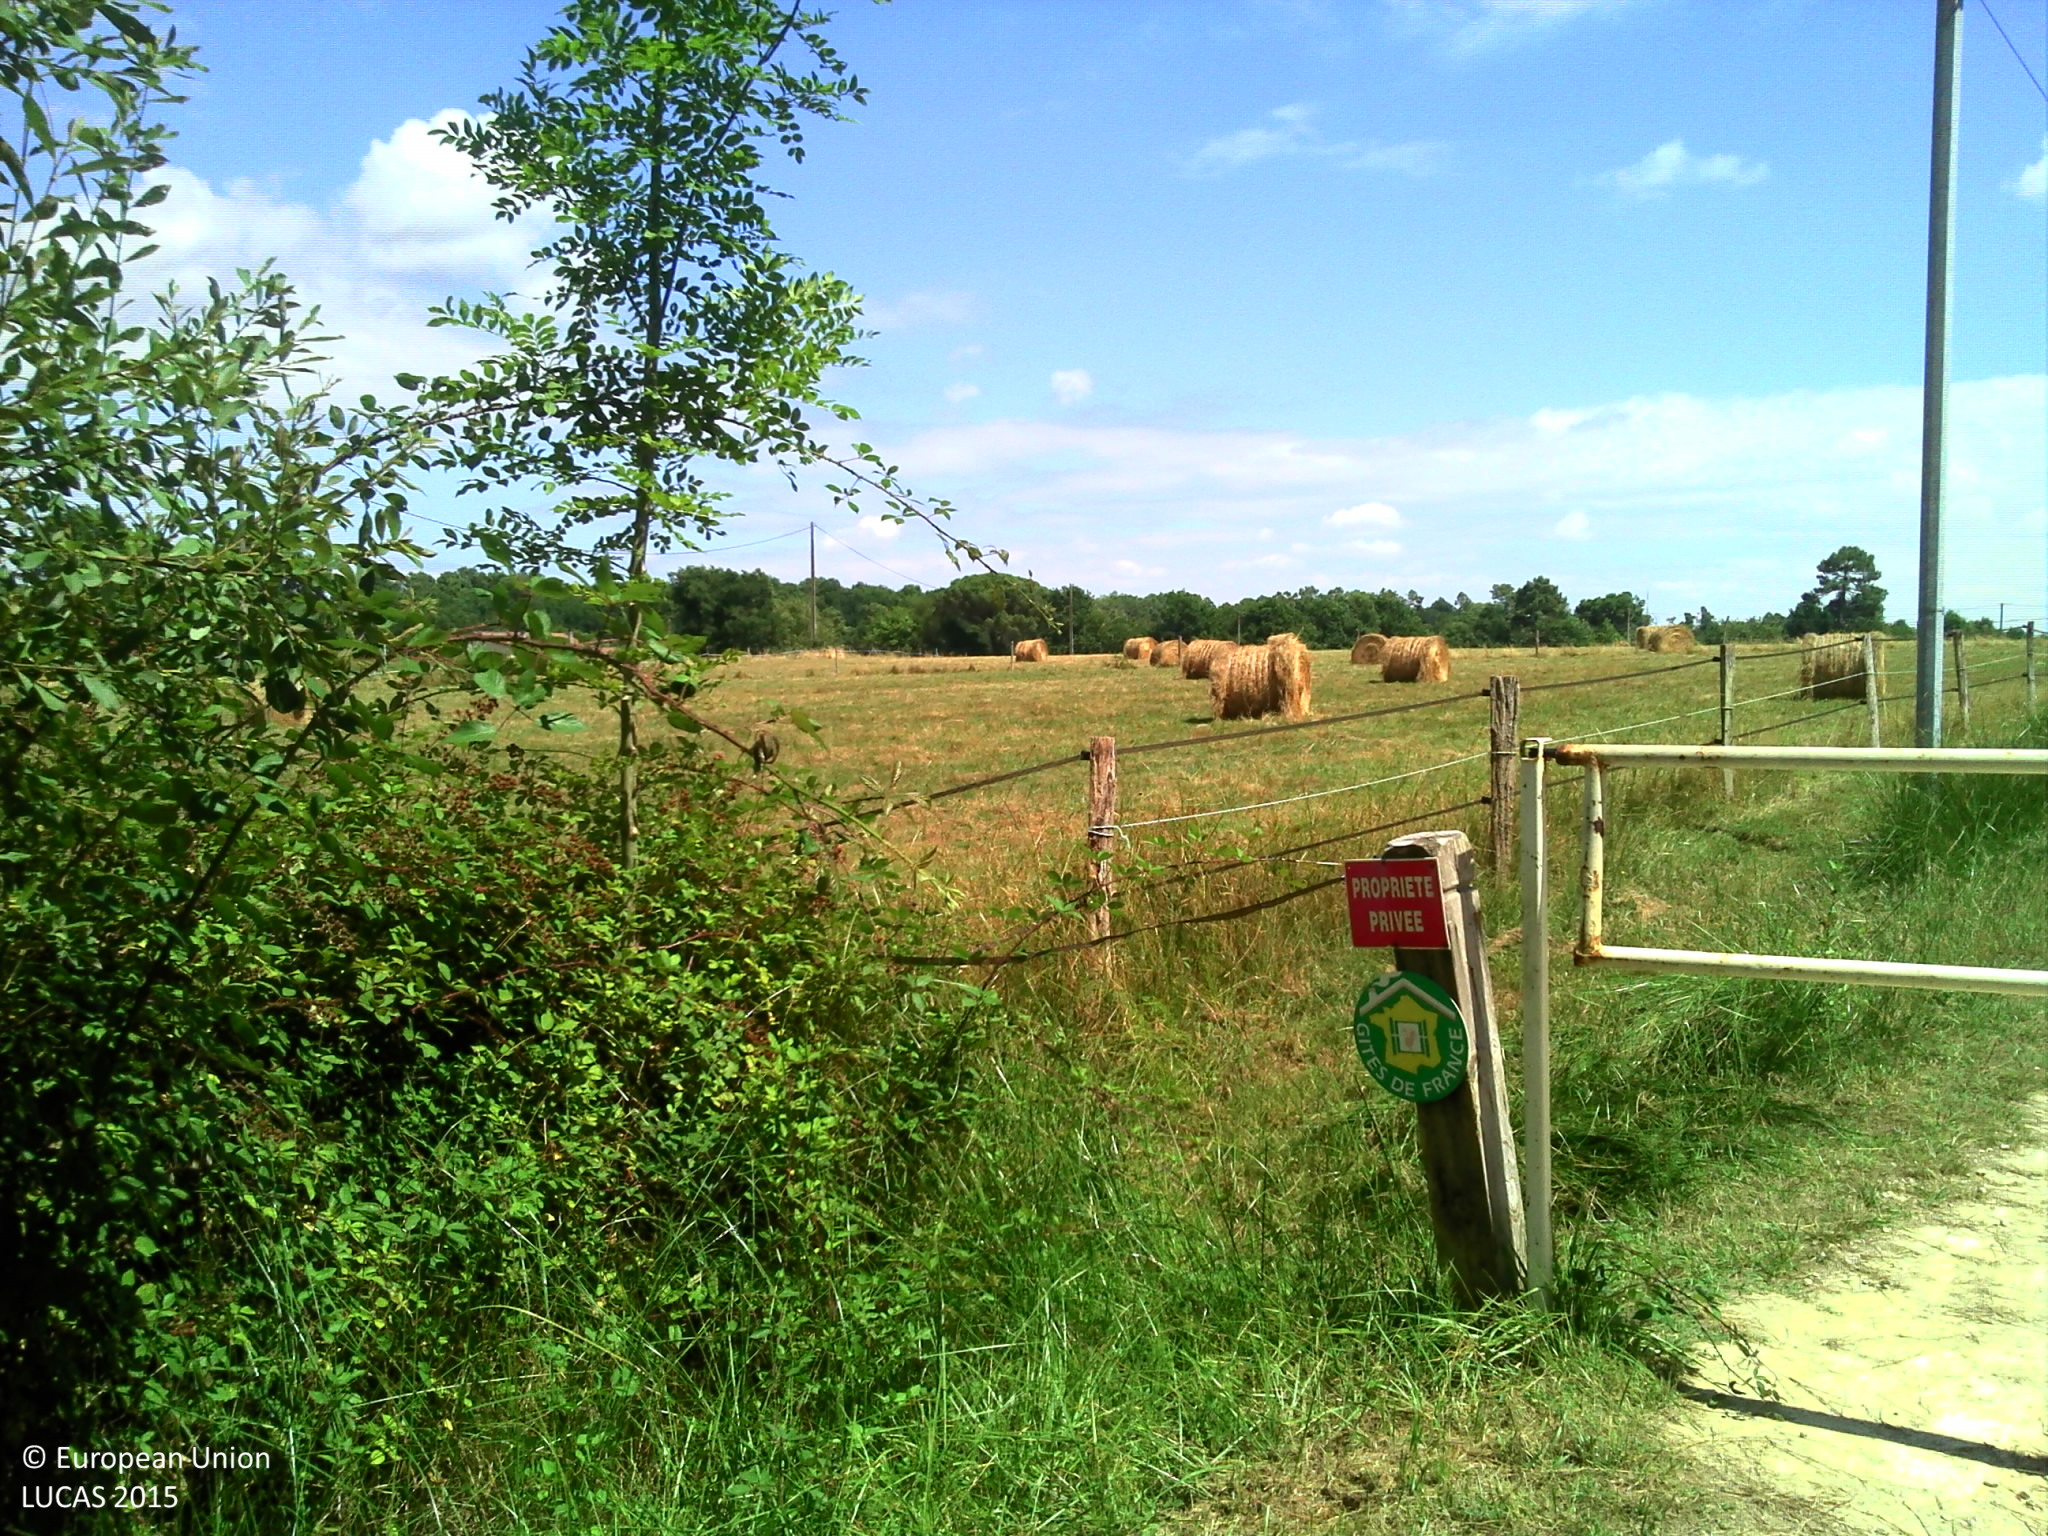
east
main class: Grassland
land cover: Grassland without tree/shrub cover
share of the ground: > 75 %
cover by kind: herbaceous plants 100 %
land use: Agriculture (excluding fallow land and kitchen gardens)
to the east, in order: Grassland without tree/shrub cover; Fences; Grassland without tree/shrub cover; Fences; Grassland without tree/shrub cover; Fences; Electric lines; Fences; Grassland without tree/shrub cover; Fences; Tracks; Broadleaved woodland
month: July
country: FR
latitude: 43.8682
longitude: -0.5266
